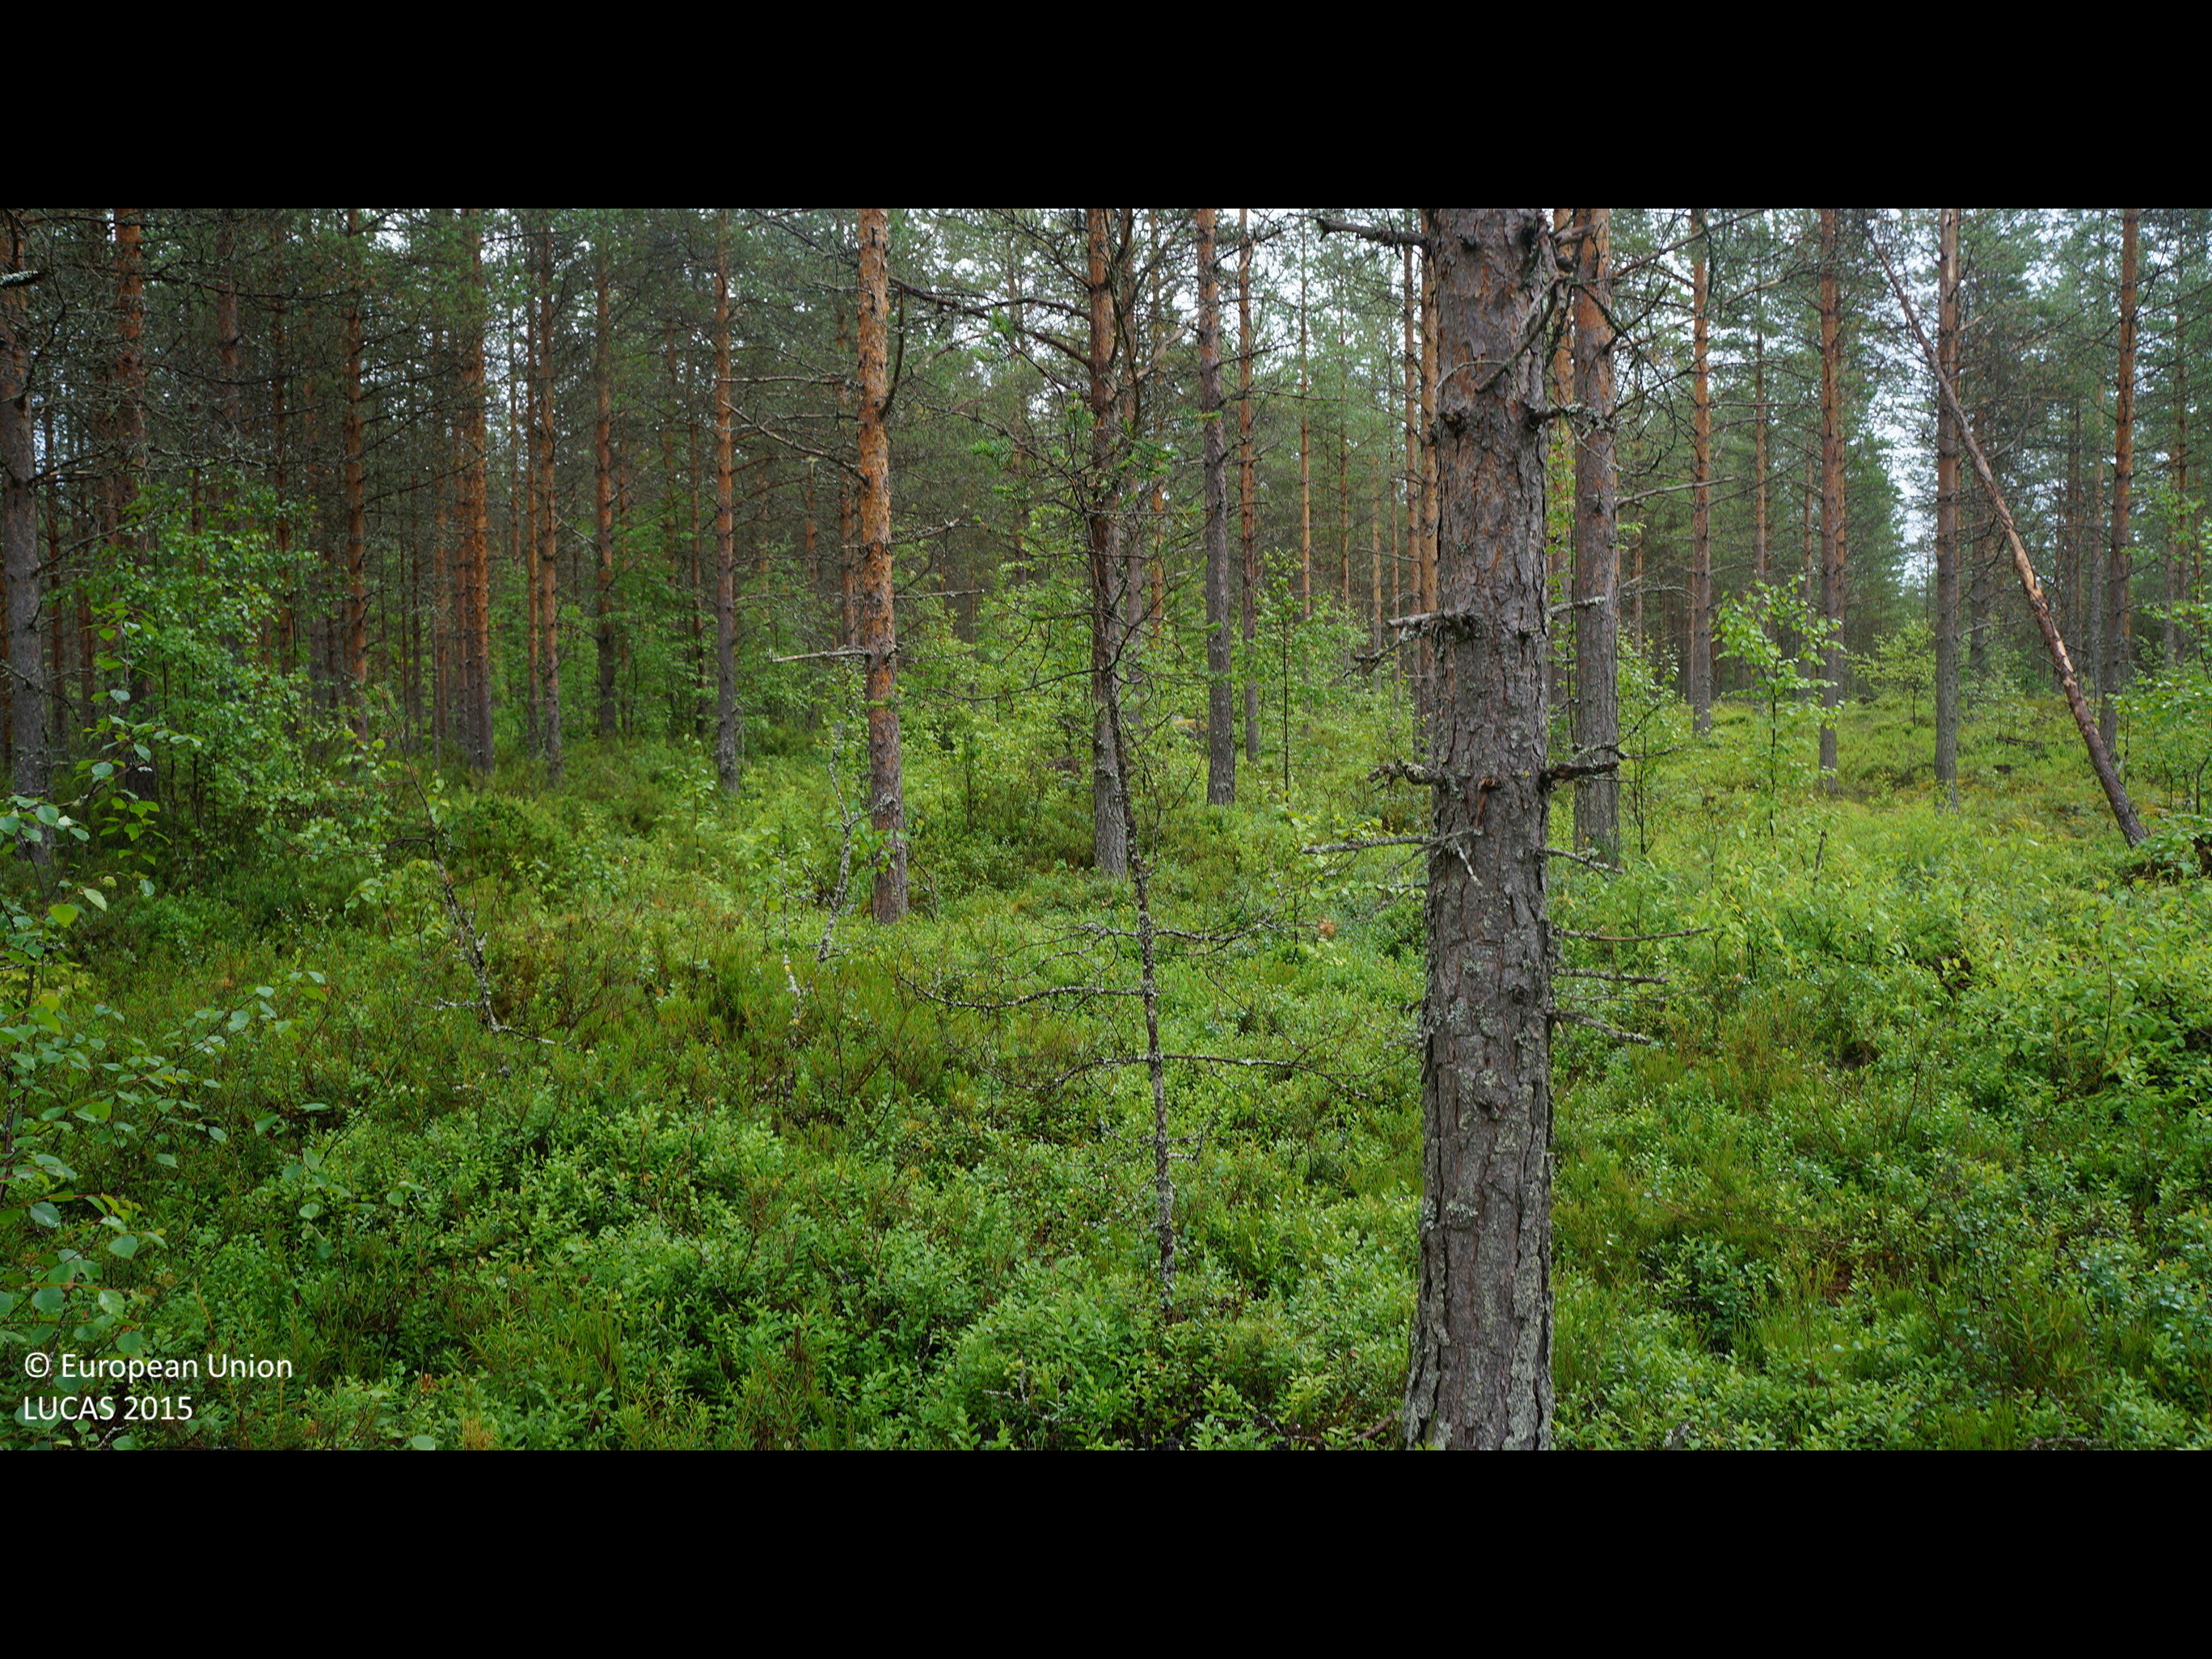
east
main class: Woodland
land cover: Pine dominated coniferous woodland
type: boreal forest
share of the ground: 50 - 75 %
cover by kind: coniferous forest trees 55 %, shrubs 40 %, broadleaved forest trees 5 %
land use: Forestry
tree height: > 5 m
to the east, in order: Ditches and canals; Pine dominated coniferous woodland; Ditches and canals; Pine dominated coniferous woodland; Ditches and canals; Pine dominated coniferous woodland; Ditches and canals; Pine dominated coniferous woodland; Ditches and canals; Pine dominated coniferous woodland; Ditches and canals; Pine dominated coniferous woodland
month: July
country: FI
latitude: 64.4767
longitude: 24.5689
